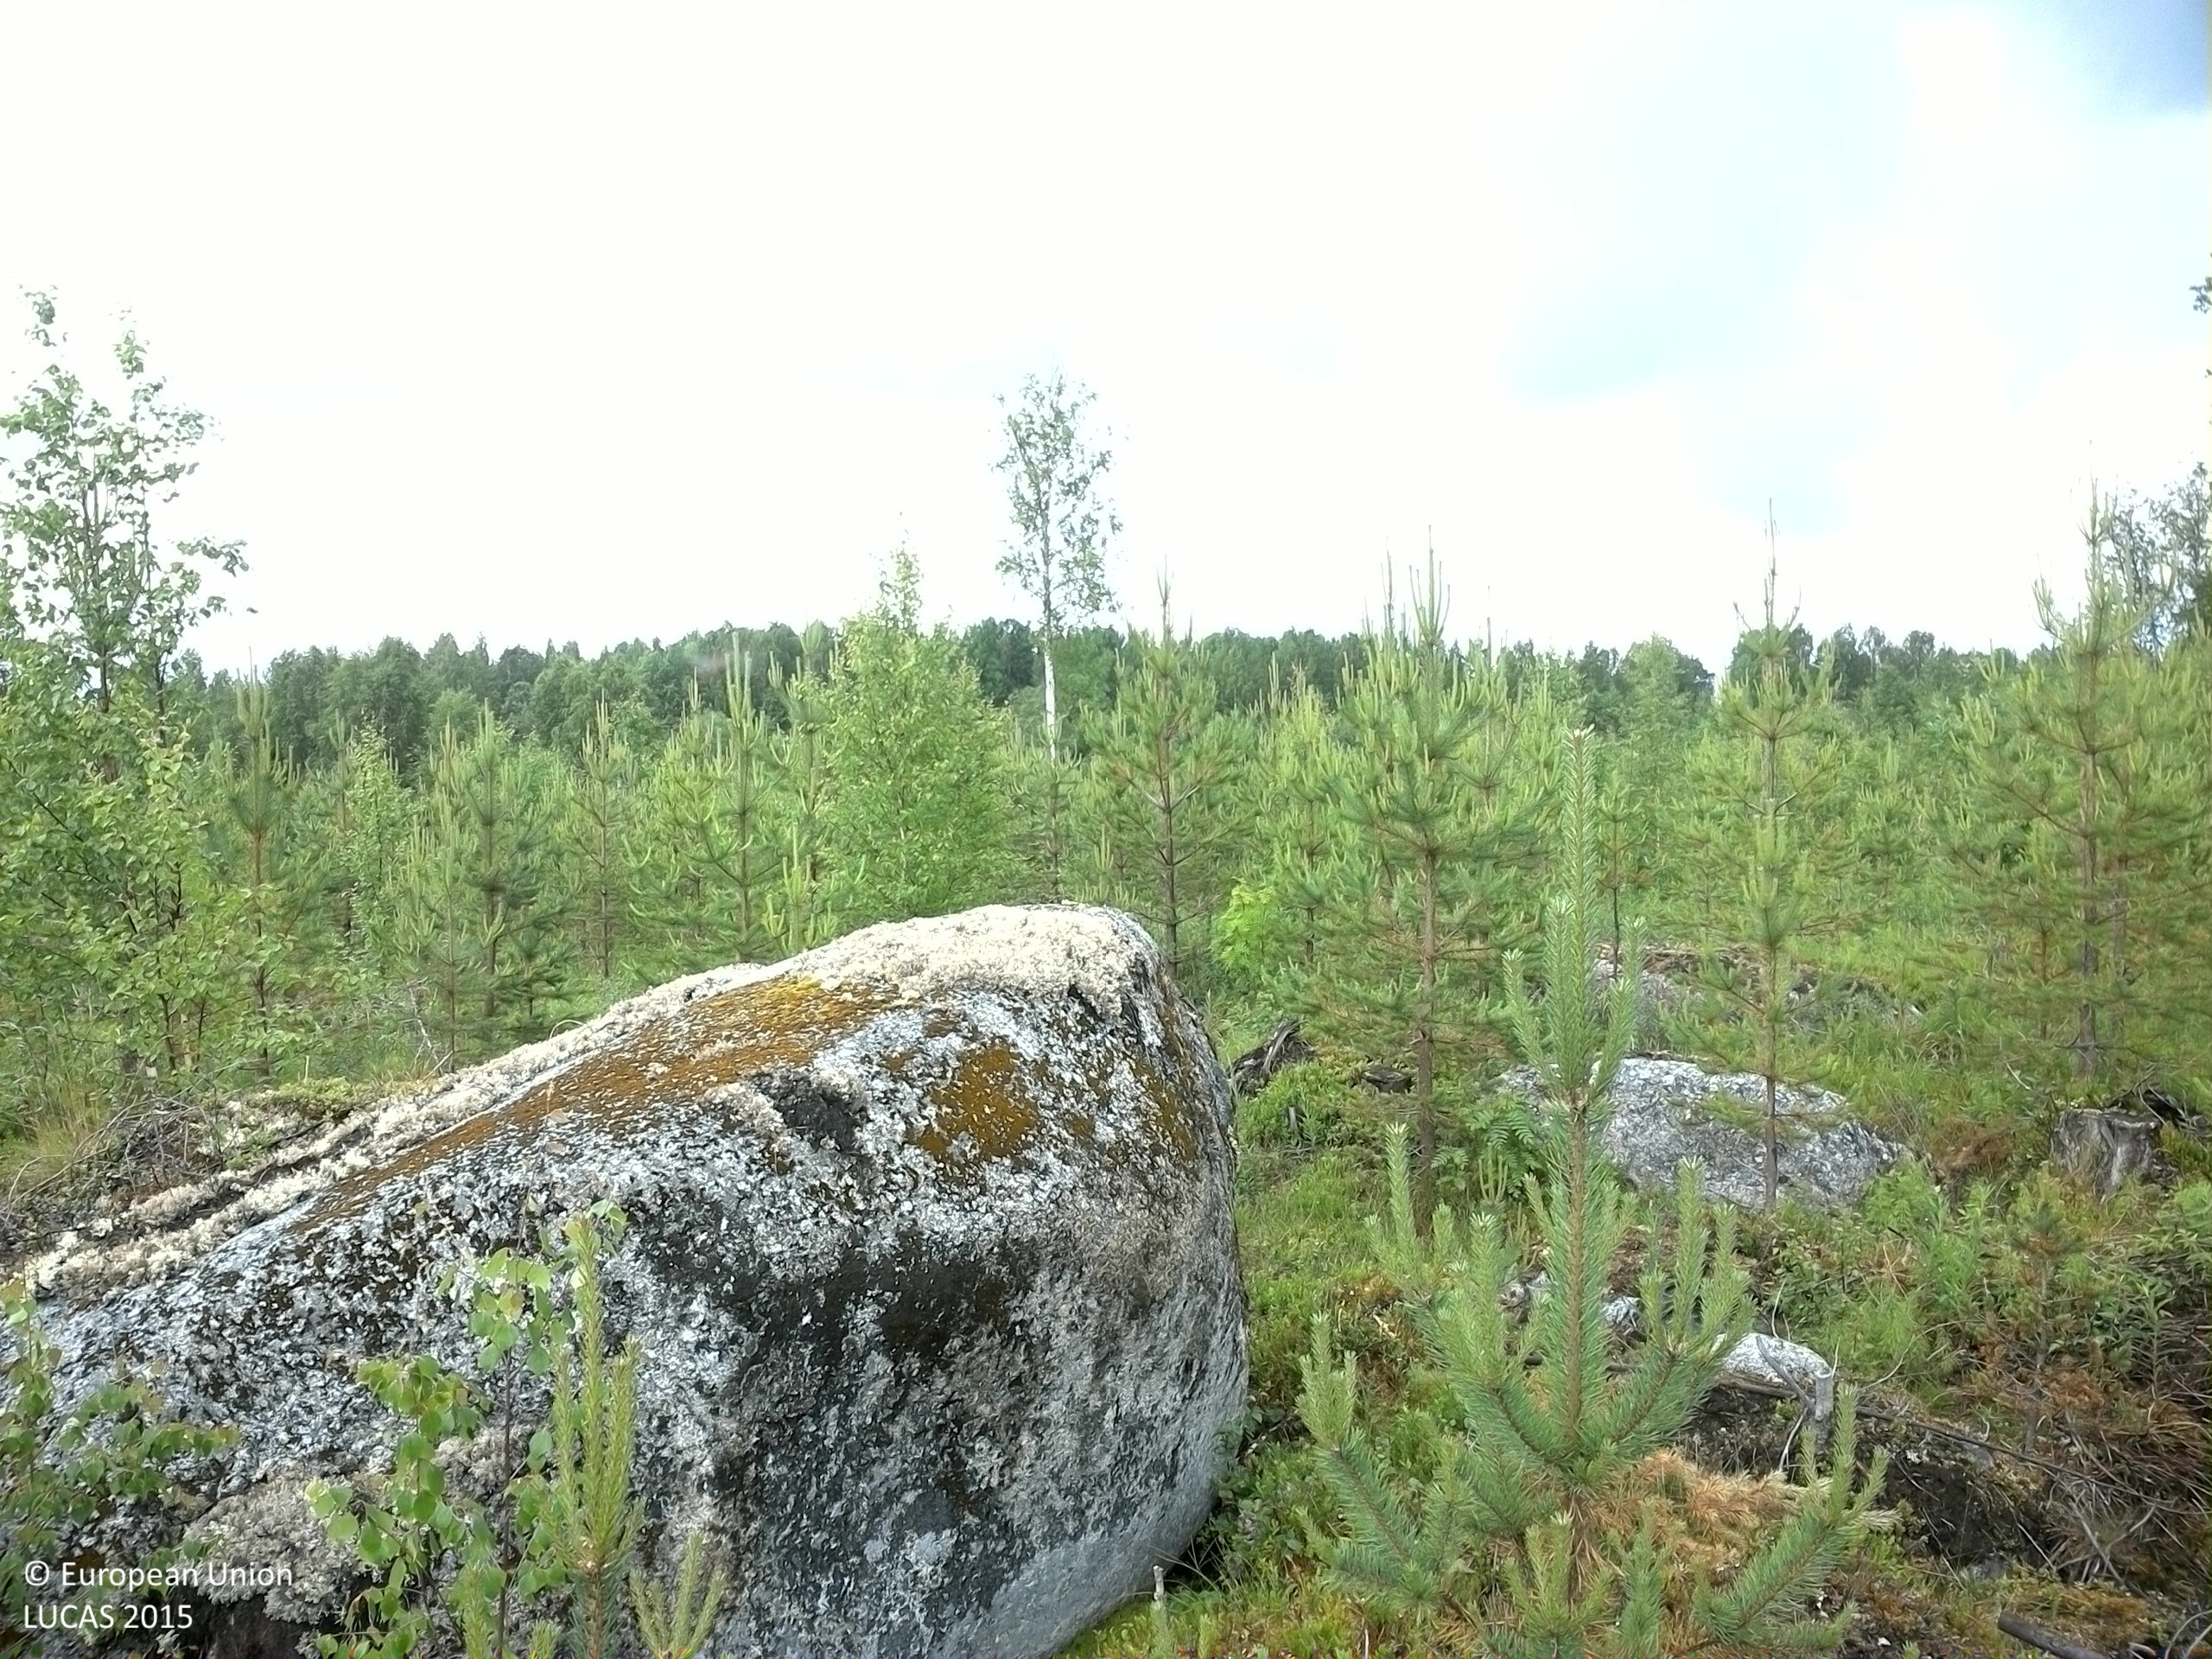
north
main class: Woodland
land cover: Pine dominated coniferous woodland
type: boreal forest
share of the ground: 25 - 50 %
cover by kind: coniferous forest trees 40 %, shrubs 20 %, herbaceous plants 20 %, lichens and mosses 15 %, broadleaved forest trees 5 %
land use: Forestry
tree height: < 5 m
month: July
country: SE
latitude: 63.6156
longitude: 18.6686
